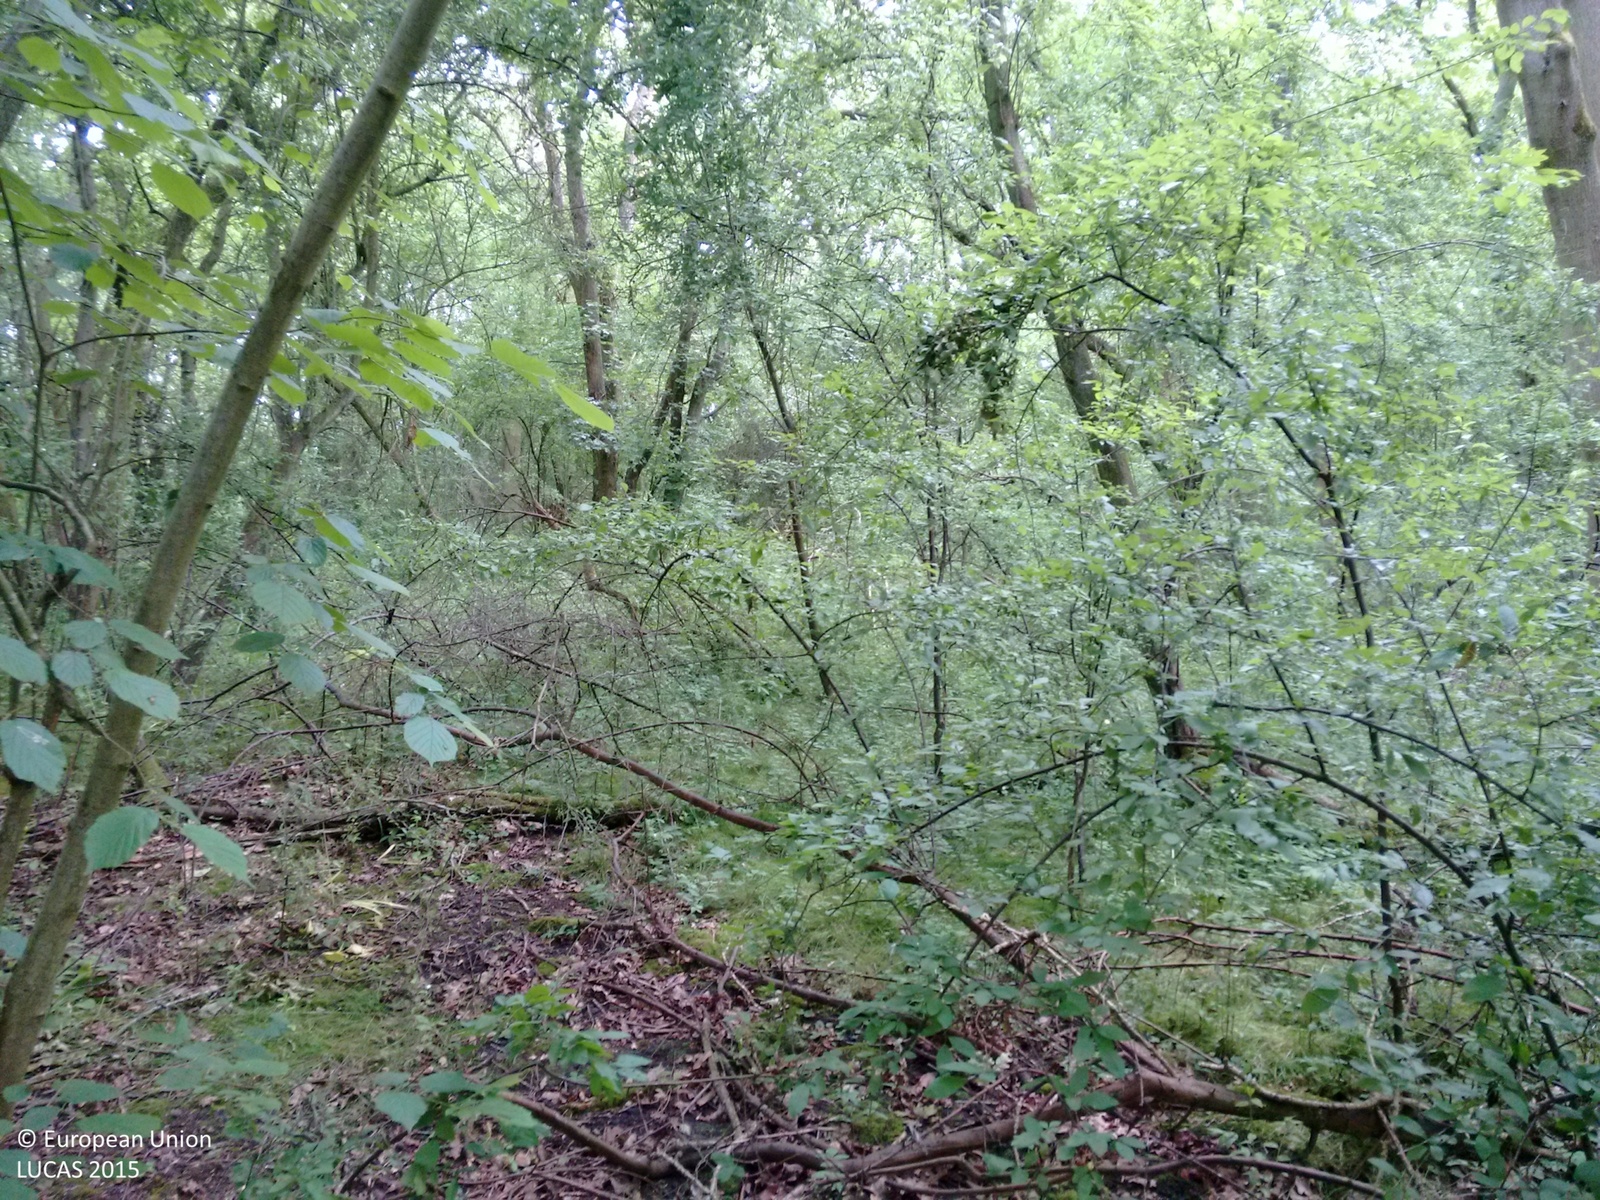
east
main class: Woodland
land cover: Broadleaved woodland
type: mesophytic deciduous forest
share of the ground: > 75 %
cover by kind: broadleaved forest trees 90 %, herbaceous plants 10 %
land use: Semi-natural and natural areas not in use
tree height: > 5 m
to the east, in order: Broadleaved woodland; Ditches and canals; Grassland without tree/shrub cover
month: June
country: GB
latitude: 52.1291
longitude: -0.6897
